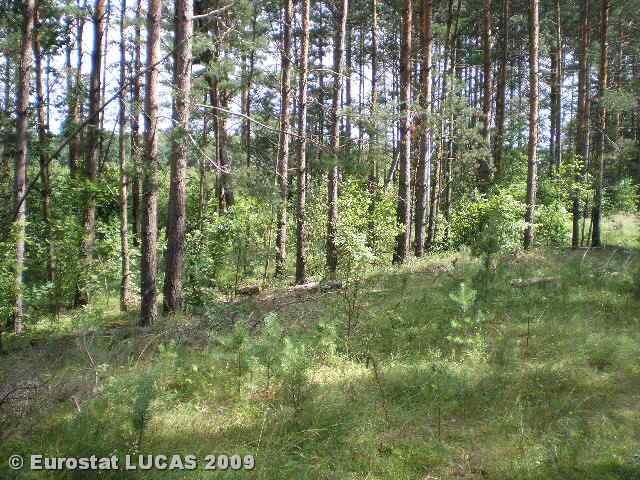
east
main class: Woodland
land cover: Mixed woodland
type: hemiboreal forest and nemoral coniferous forest and mixed broadleaved-coniferous forest
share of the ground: > 75 %
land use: Forestry
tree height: > 5 m
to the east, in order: Mixed woodland; Grassland with sparse tree/shrub cover; Electric lines; Grassland with sparse tree/shrub cover; Mixed woodland; Grassland with sparse tree/shrub cover; Oats; Grass margins; Tracks; Grassland without tree/shrub cover; Electric lines; Grassland without tree/shrub cover
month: July
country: LT
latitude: 54.8674
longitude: 25.3777
